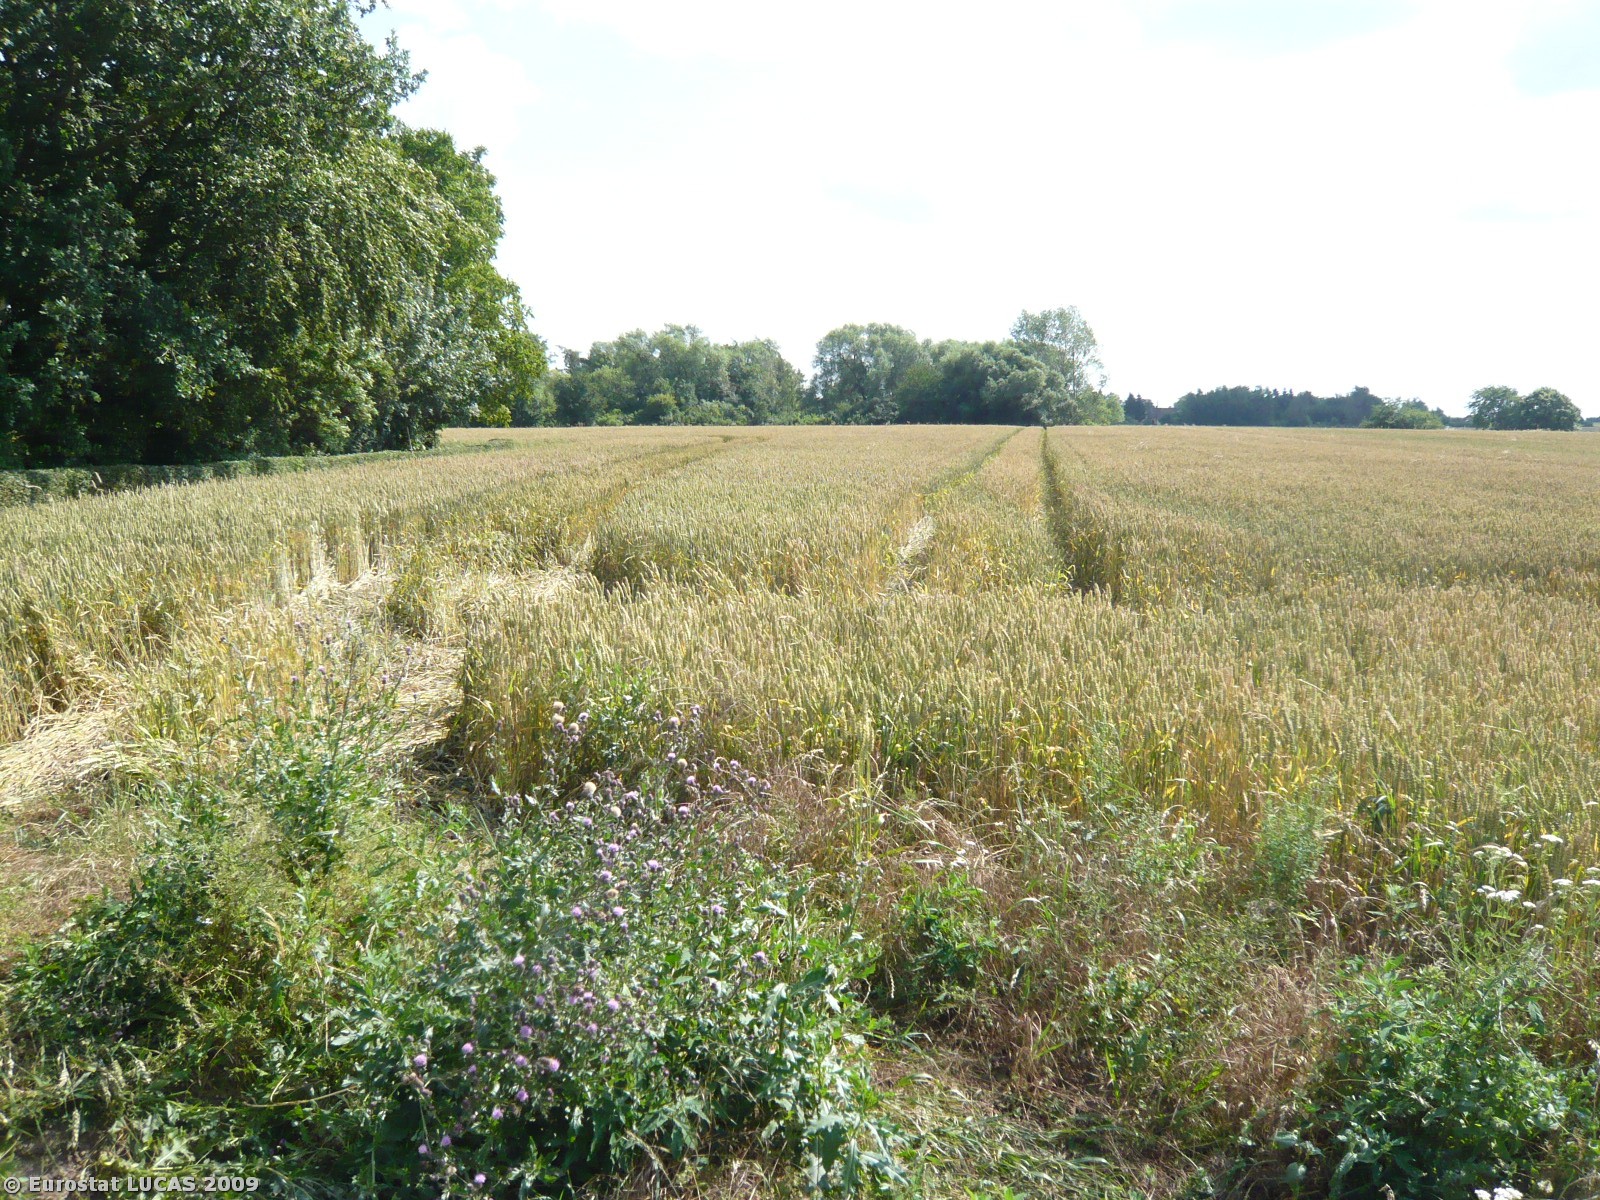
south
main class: Grassland
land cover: Grassland without tree/shrub cover
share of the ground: > 75 %
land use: Agriculture (excluding fallow land and kitchen gardens)
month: July
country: DK
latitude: 55.7625
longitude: 11.7355
